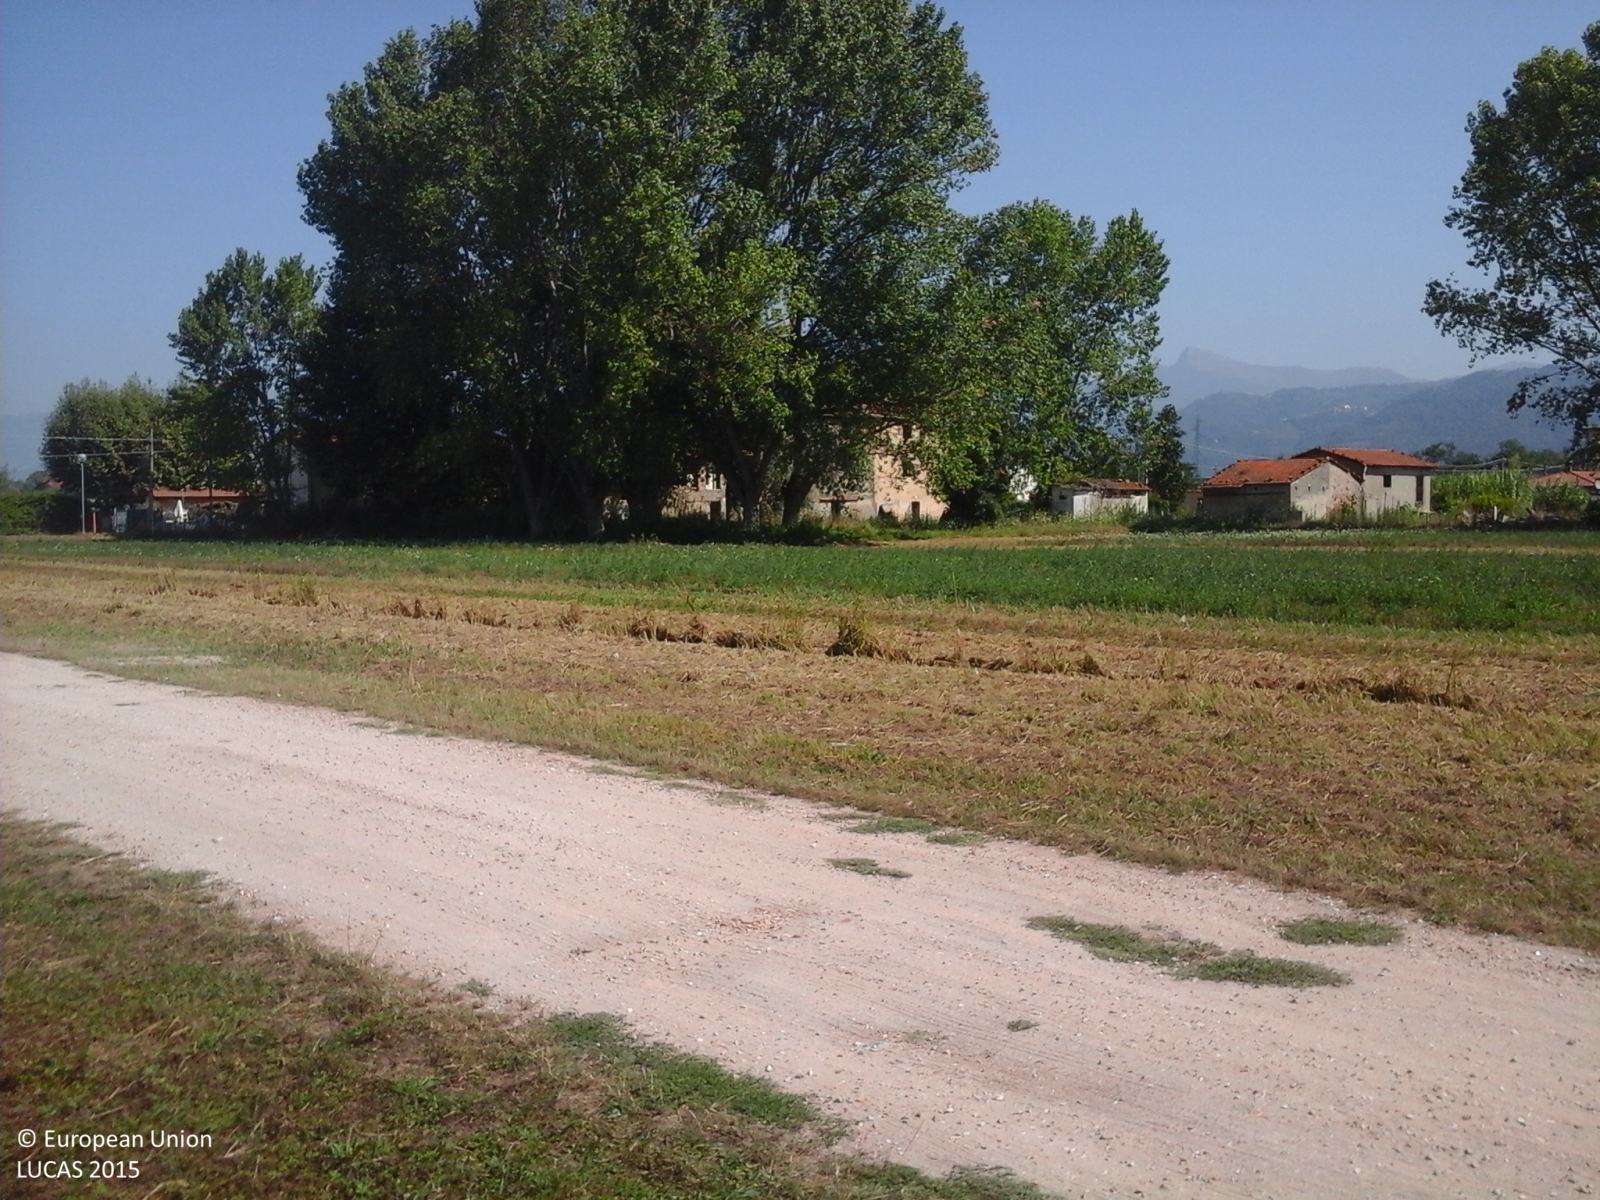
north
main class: Grassland
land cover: Spontaneously vegetated surfaces
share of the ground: > 75 %
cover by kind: herbaceous plants 100 %
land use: Fallow land
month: August
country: IT
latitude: 43.8812
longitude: 10.2607
